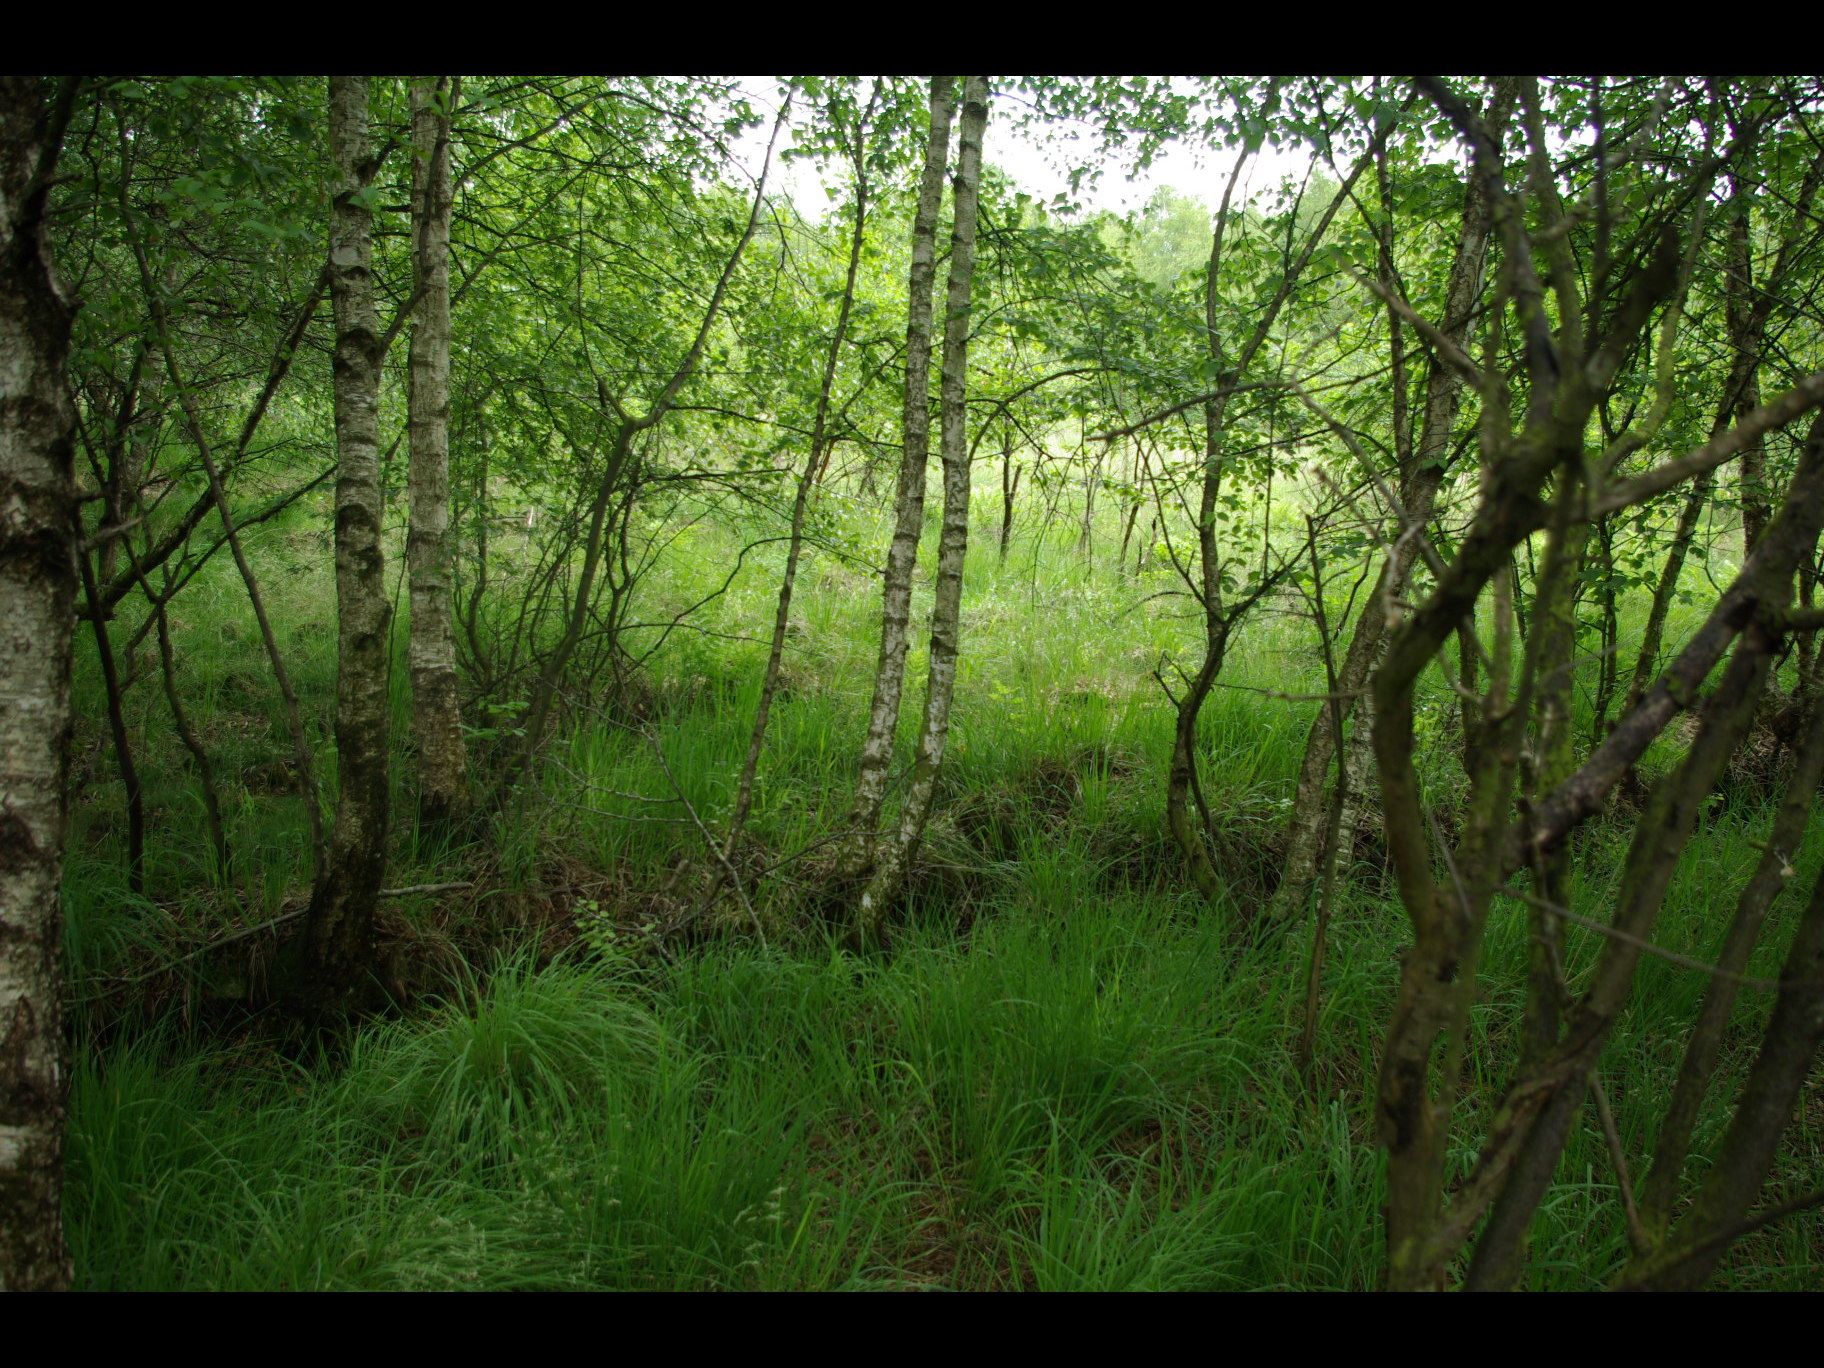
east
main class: Woodland
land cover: Broadleaved woodland
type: mire and swamp forests
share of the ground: > 75 %
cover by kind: broadleaved forest trees 70 %, herbaceous plants 20 %, lichens and mosses 10 %
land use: Semi-natural and natural areas not in use
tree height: < 5 m
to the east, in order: Broadleaved woodland; Peatbogs; Broadleaved woodland; Inland fresh water bodies; Broadleaved woodland; Peatbogs; Broadleaved woodland; Inland fresh water bodies
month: June
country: DE
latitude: 54.1567
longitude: 9.9541
